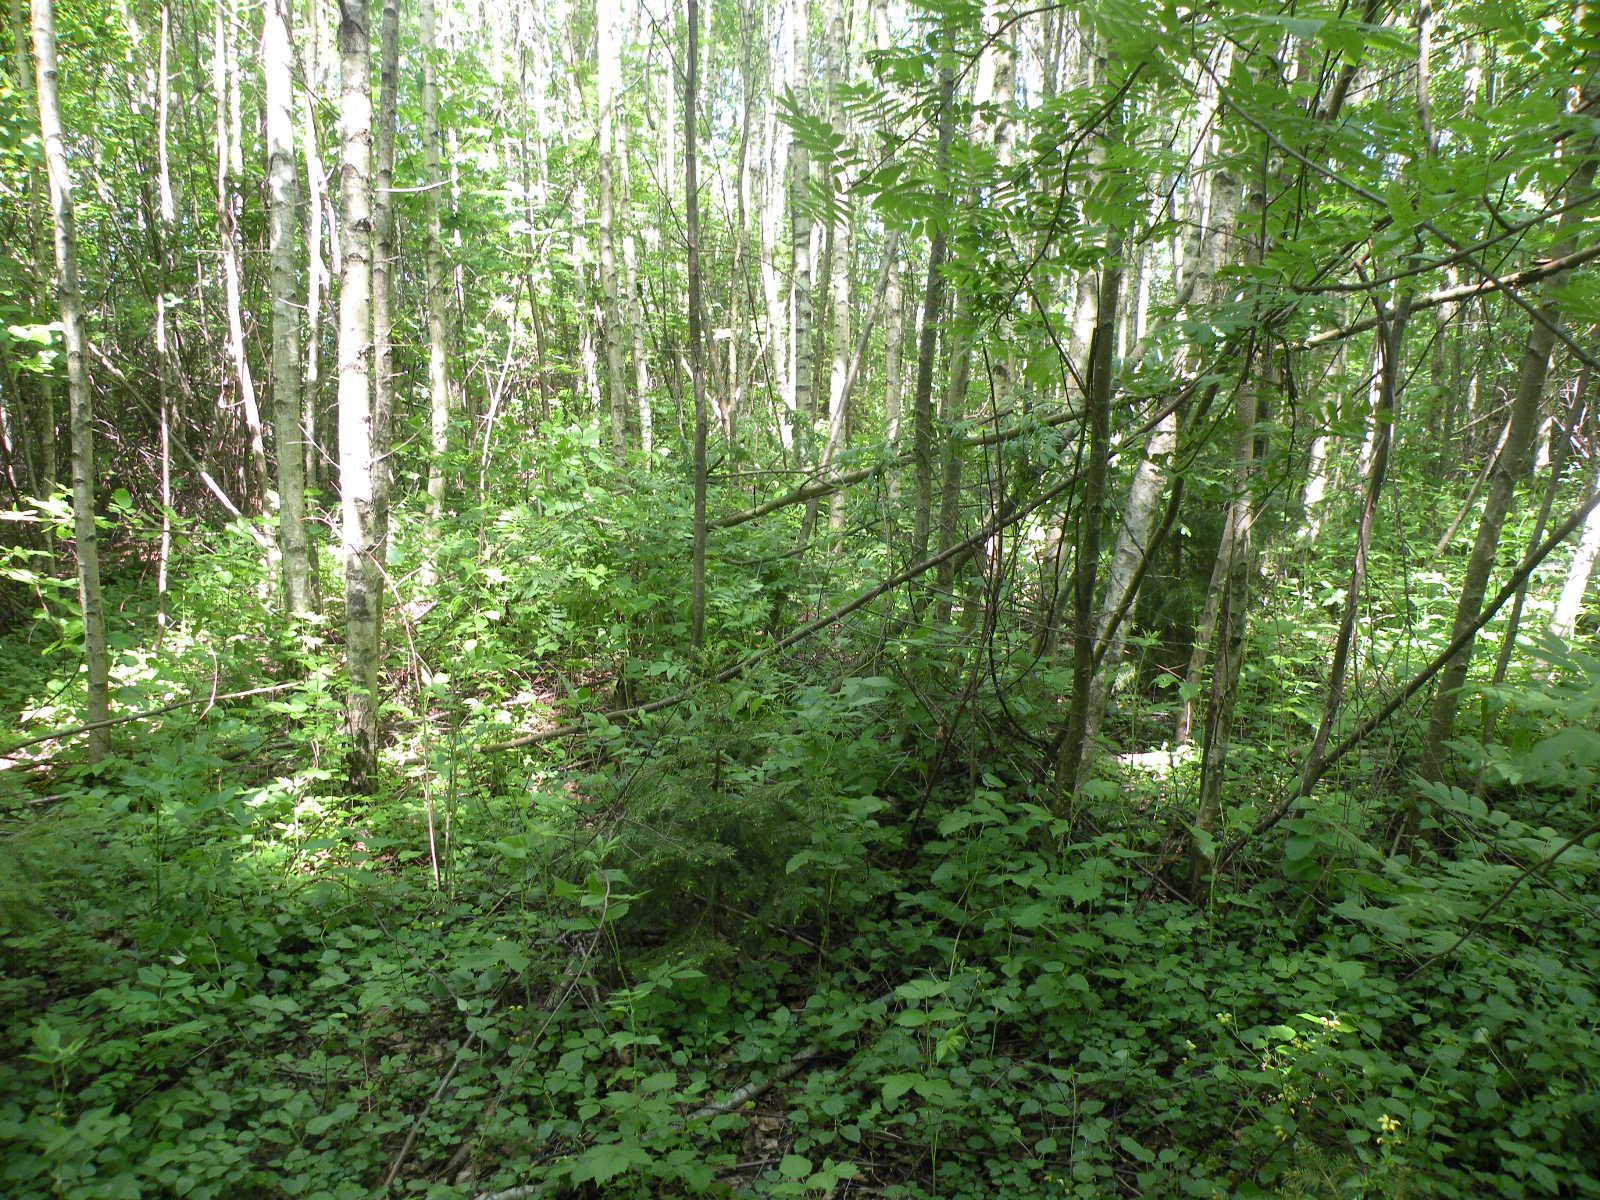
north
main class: Woodland
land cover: Broadleaved woodland
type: non-riverine alder, birch or aspen forest
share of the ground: > 75 %
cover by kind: broadleaved forest trees 80 %, shrubs 10 %, herbaceous plants 10 %
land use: Forestry
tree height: > 5 m
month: May
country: LV
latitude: 55.9736
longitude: 26.2138
